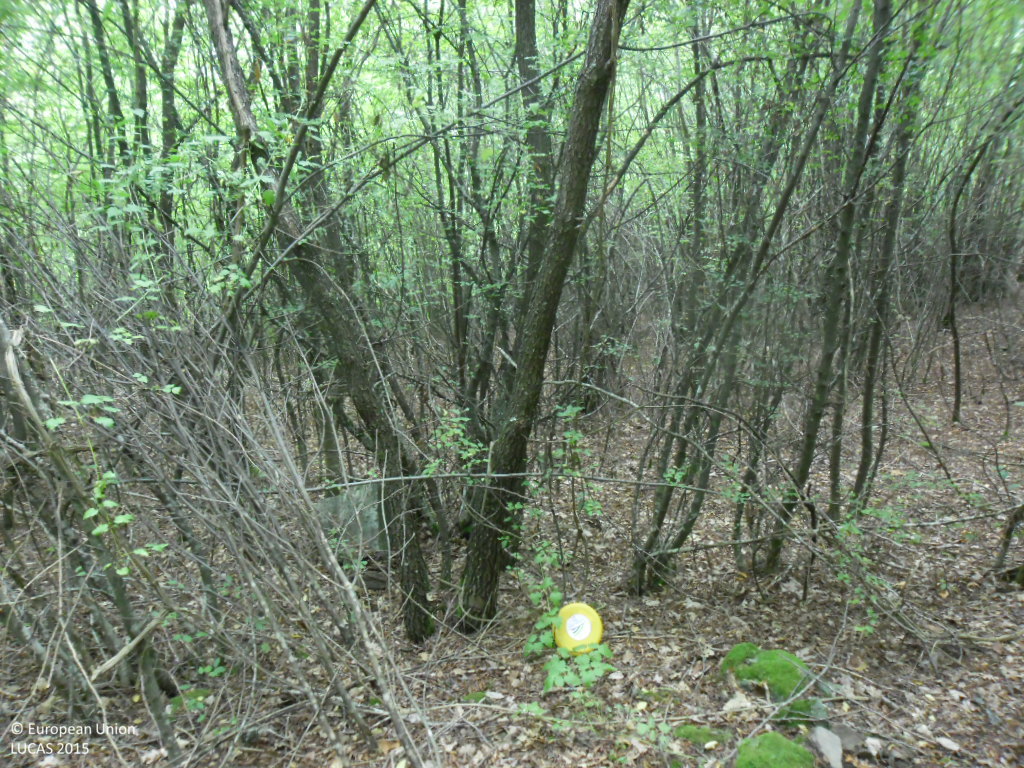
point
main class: Woodland
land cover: Broadleaved woodland
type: mesophytic deciduous forest
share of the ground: > 75 %
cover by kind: broadleaved forest trees 95 %, unconsolidated bare surface 5 %
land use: Forestry
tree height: > 5 m
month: September
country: BG
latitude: 41.9741
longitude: 23.0199
